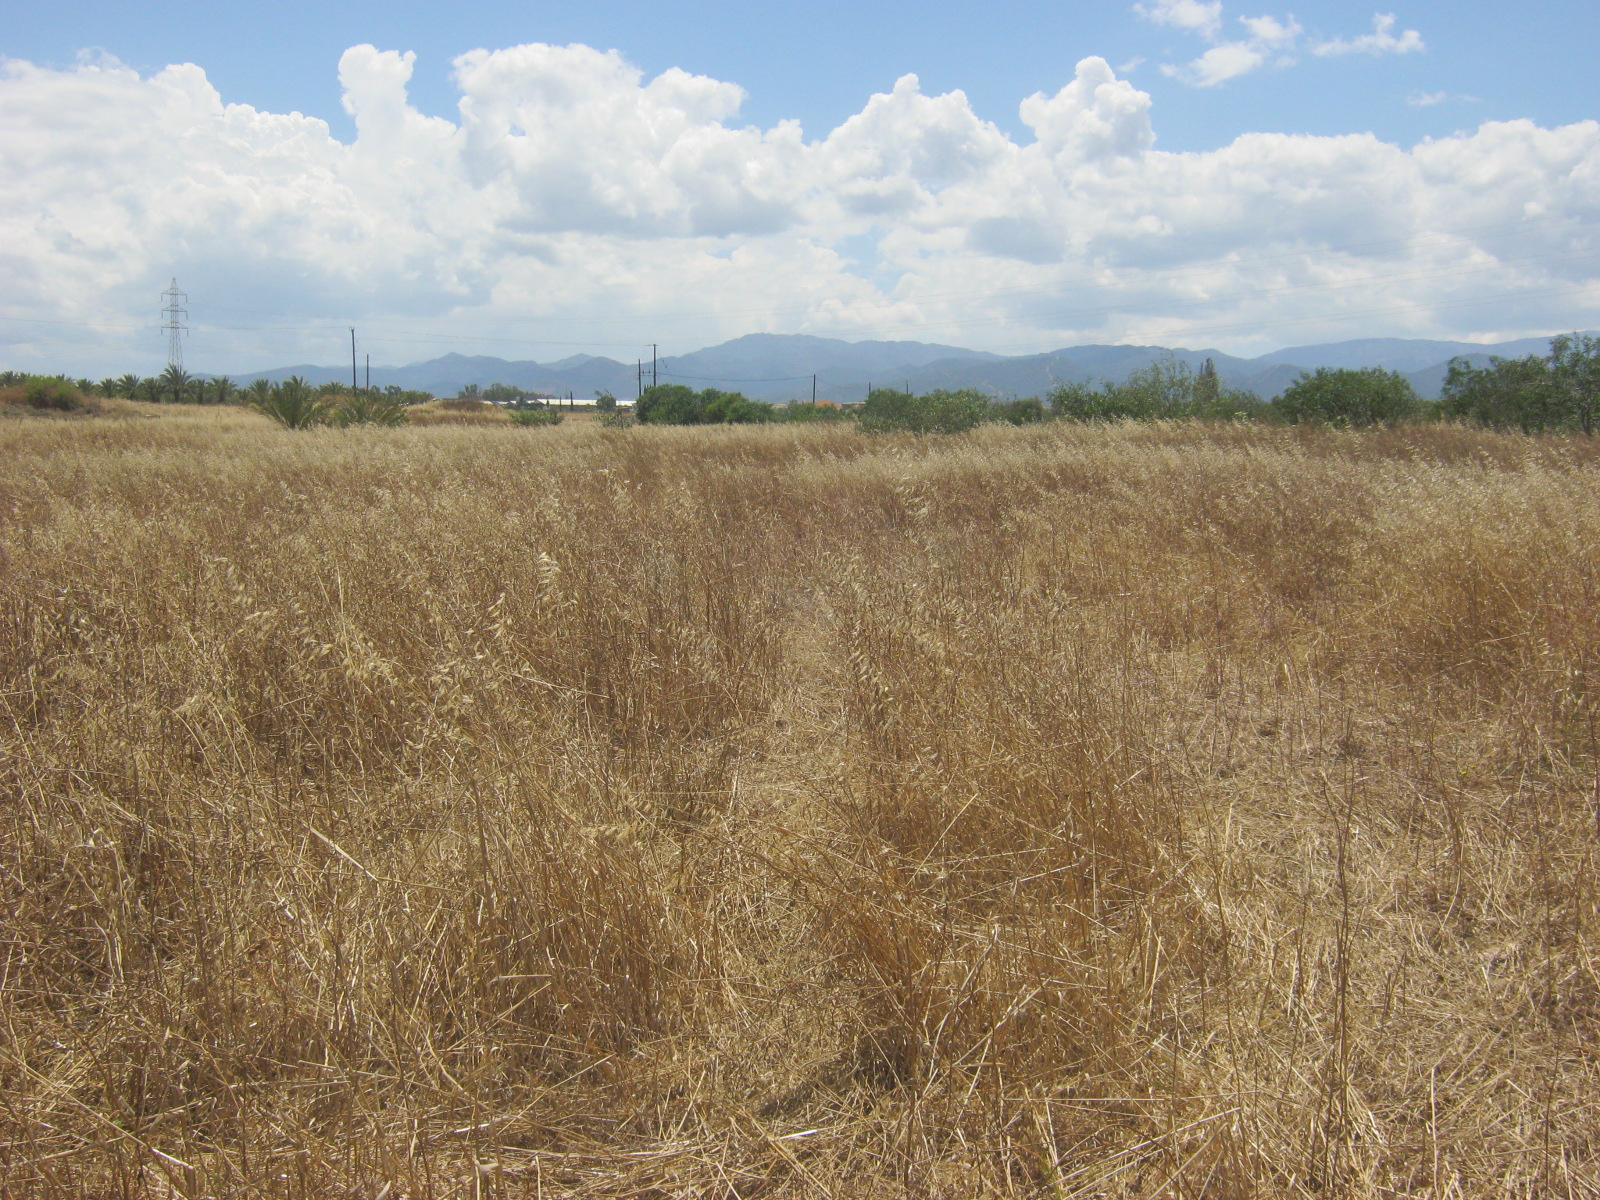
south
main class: Grassland
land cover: Spontaneously vegetated surfaces
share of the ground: > 75 %
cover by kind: herbaceous plants 100 %
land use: Abandoned areas
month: May
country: CY
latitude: 35.1449
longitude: 33.0209
